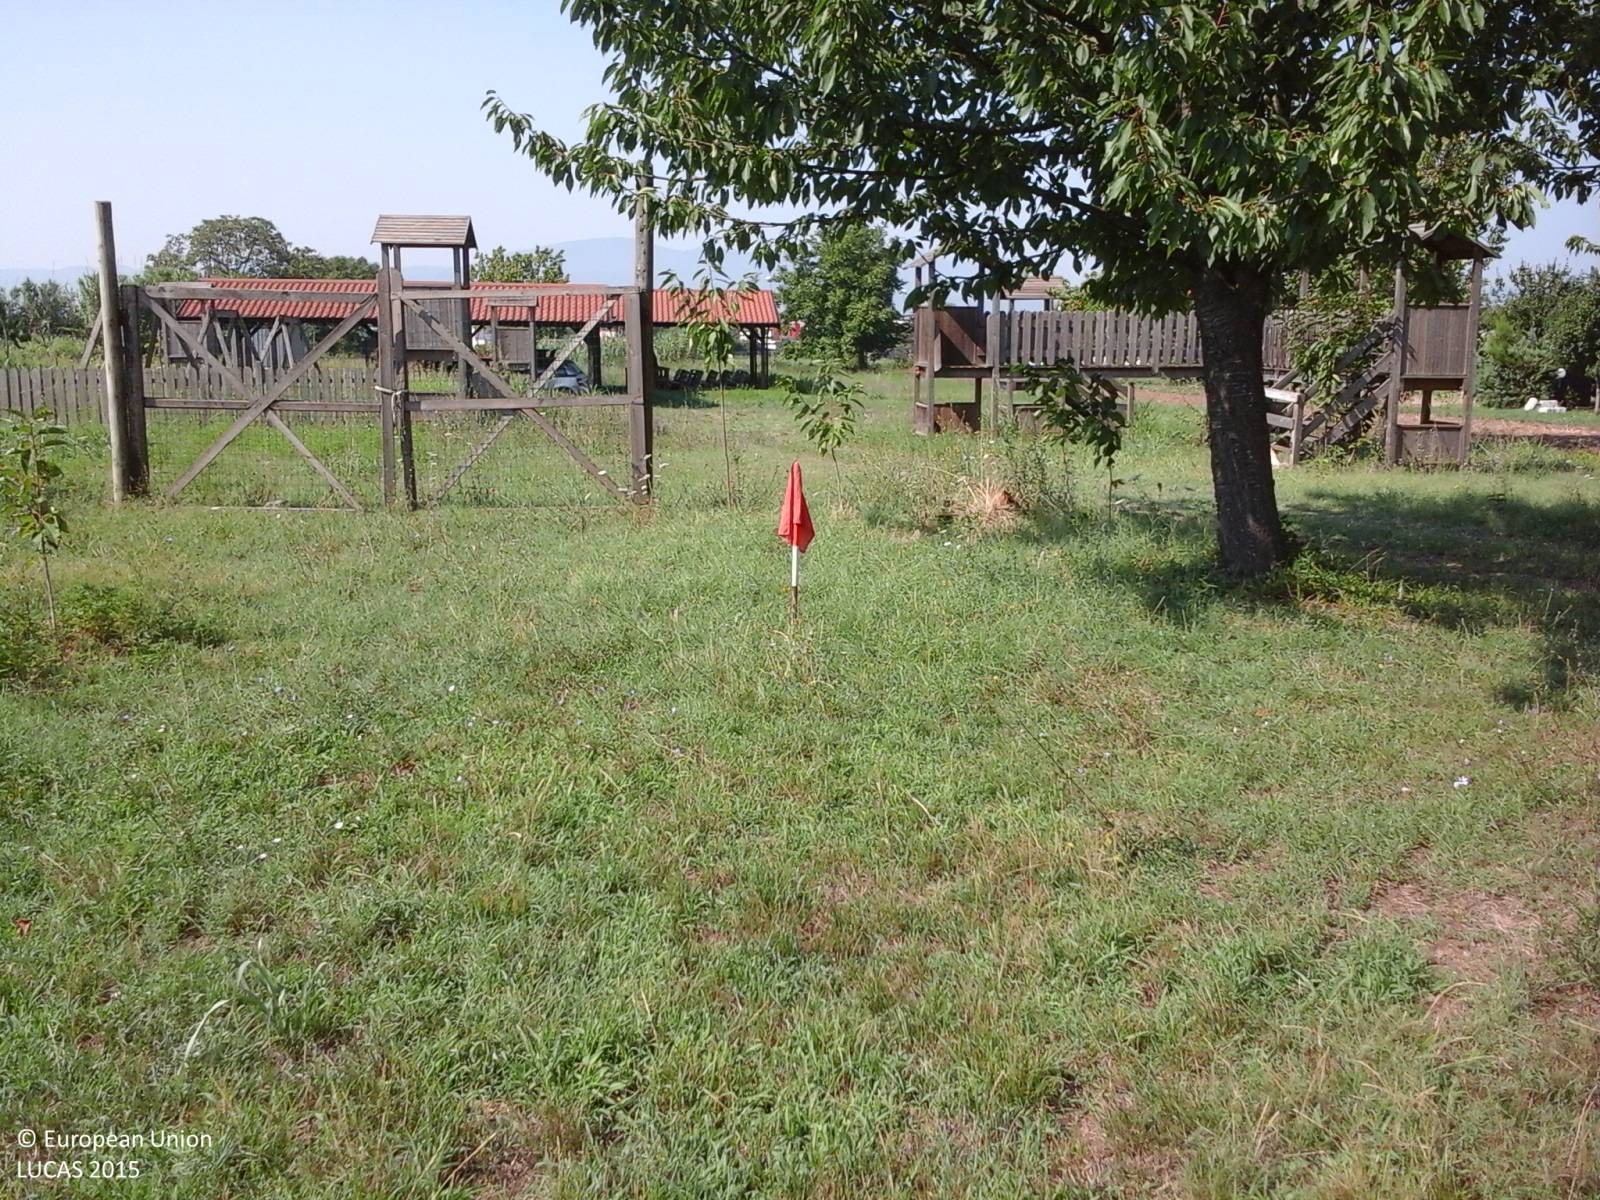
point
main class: Grassland
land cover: Grassland with sparse tree/shrub cover
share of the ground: > 75 %
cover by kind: herbaceous plants 95 %, broadleaved forest trees 5 %
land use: Amenities, museums, leisure
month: August
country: IT
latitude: 41.3474
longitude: 14.3698
